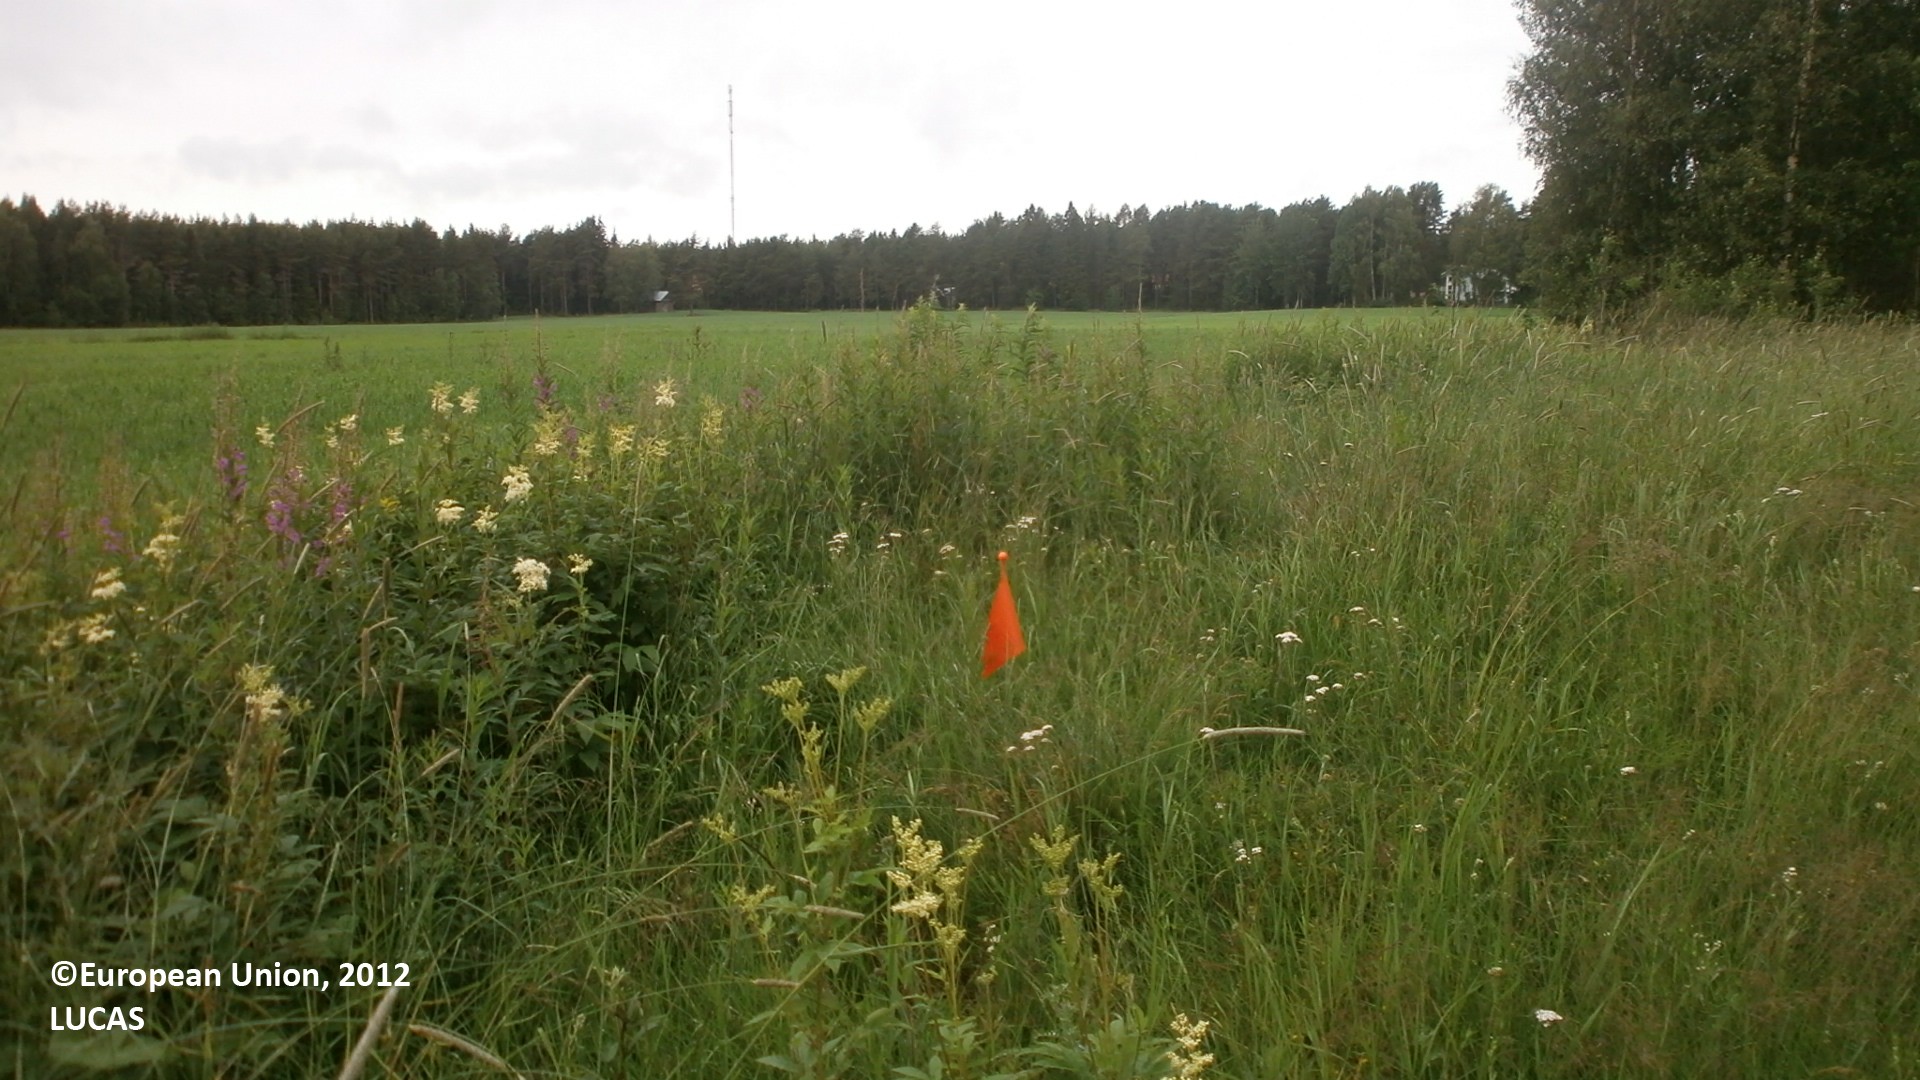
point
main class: Grassland
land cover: Grassland without tree/shrub cover
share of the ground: > 75 %
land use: Agriculture (excluding fallow land and kitchen gardens)
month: July
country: FI
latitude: 64.6009
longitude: 24.4217
